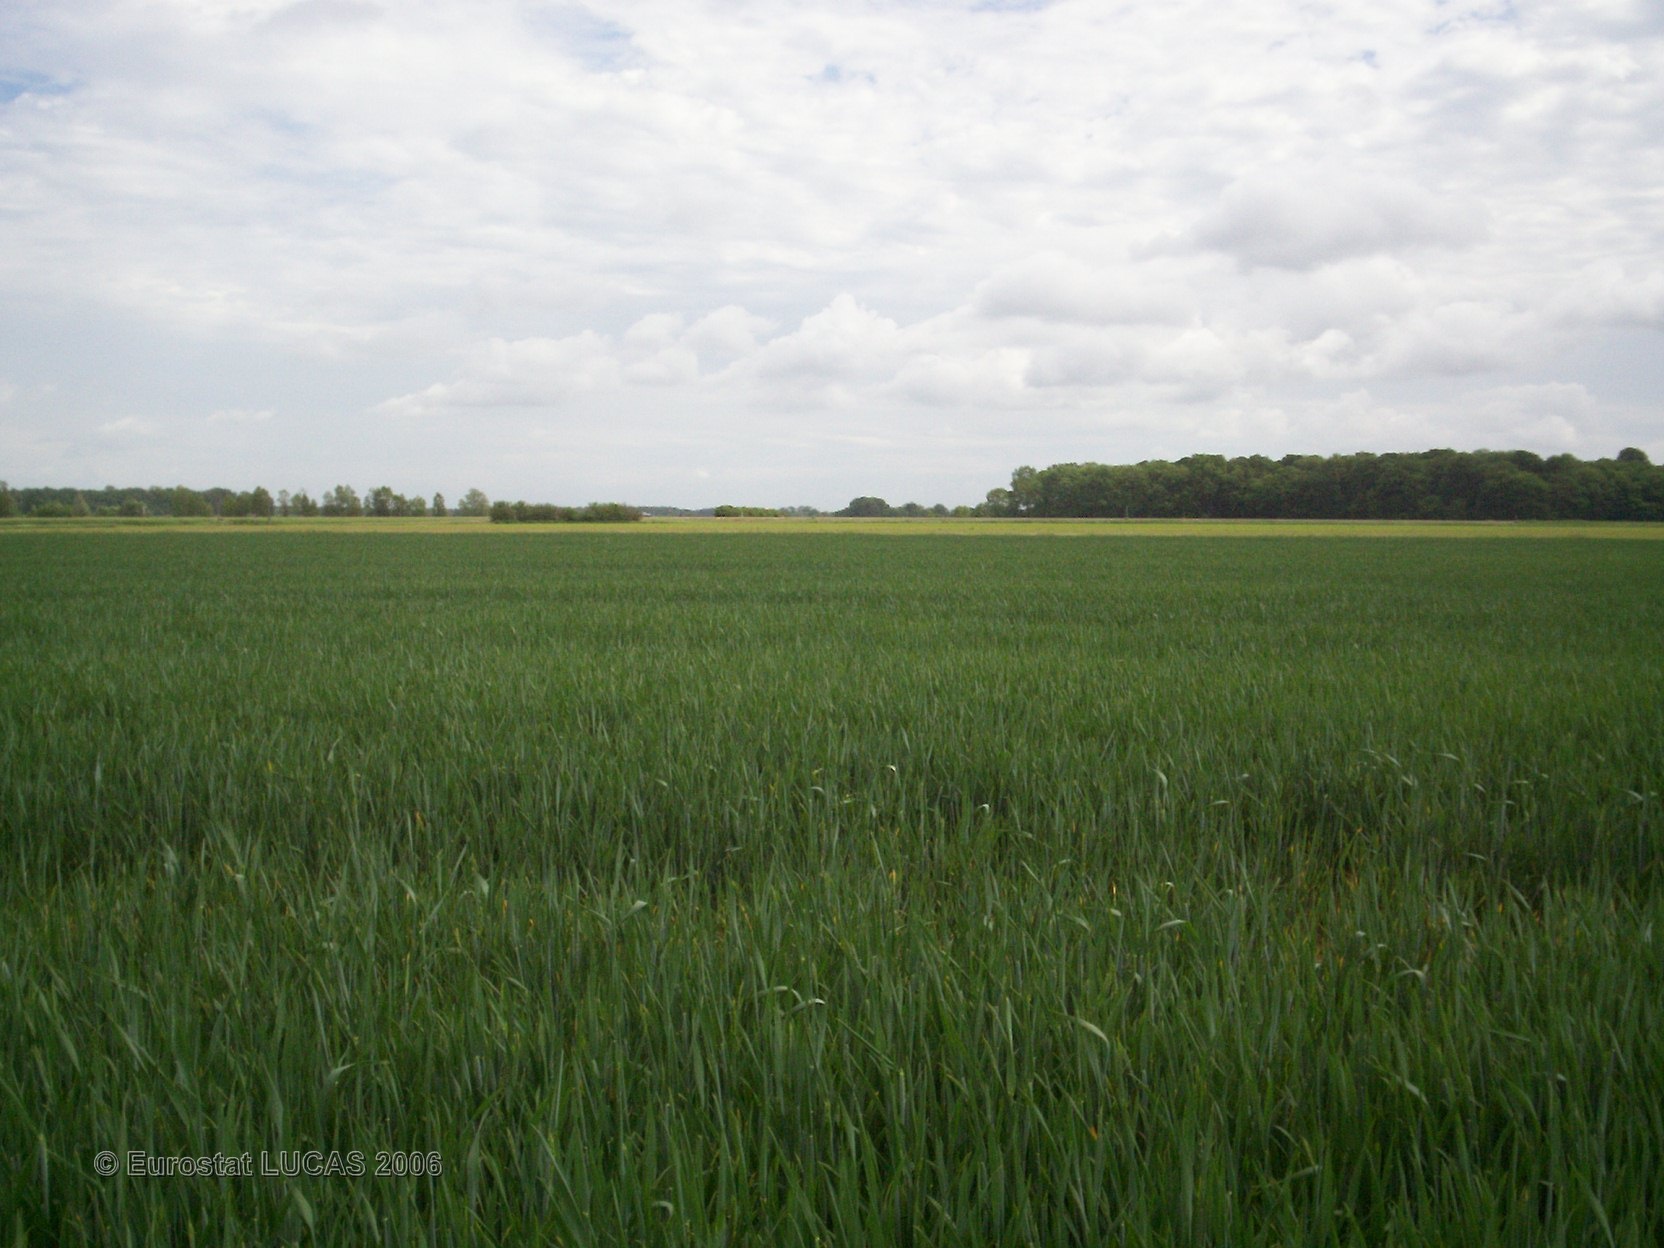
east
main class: Cropland
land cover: Common wheat
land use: Agriculture (excluding fallow land and kitchen gardens)
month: May
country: FR
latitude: 48.6748
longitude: 2.8066
